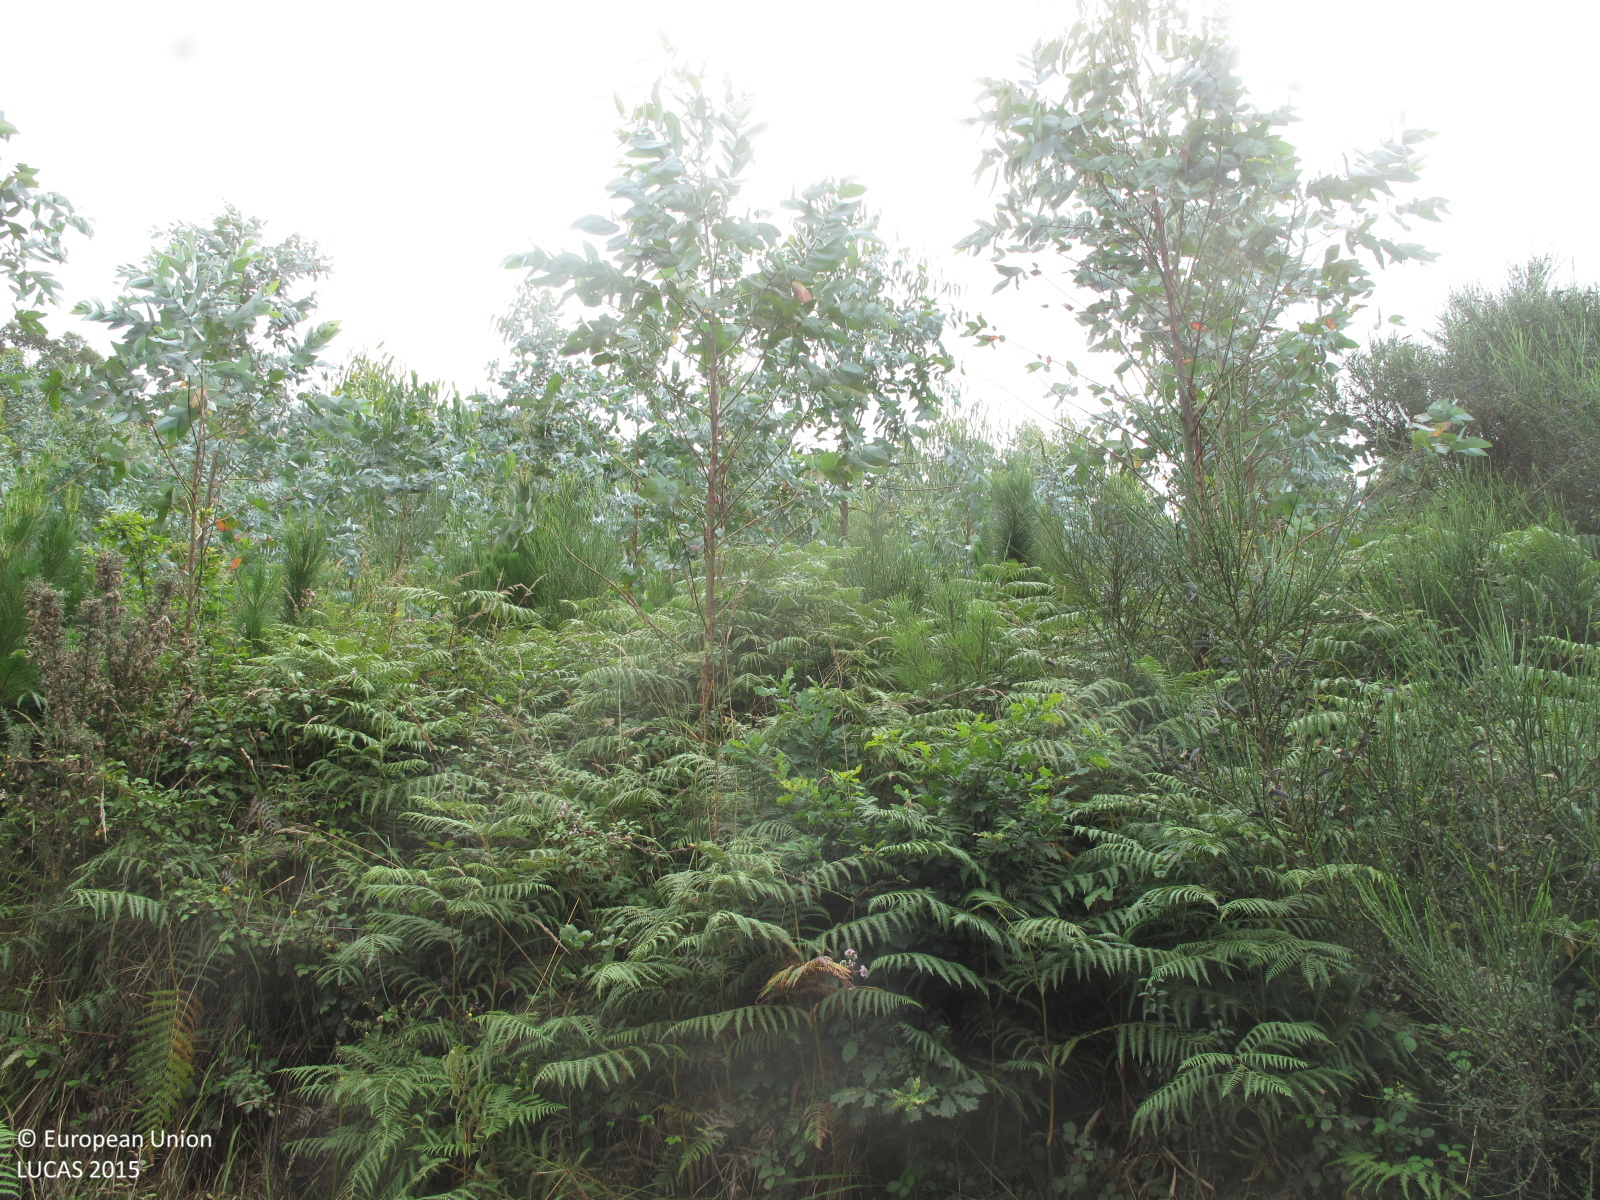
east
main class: Woodland
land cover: Broadleaved woodland
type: exotic forest
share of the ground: 25 - 50 %
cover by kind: herbaceous plants 40 %, broadleaved forest trees 35 %, shrubs 20 %, coniferous forest trees 5 %
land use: Forestry
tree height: < 5 m
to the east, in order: Broadleaved woodland; Other mixed woodland; Pine dominated coniferous woodland; Tracks; Pine dominated coniferous woodland; Shrubland without tree cover; Maize
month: July
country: ES
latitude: 43.0856
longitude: -9.2315
